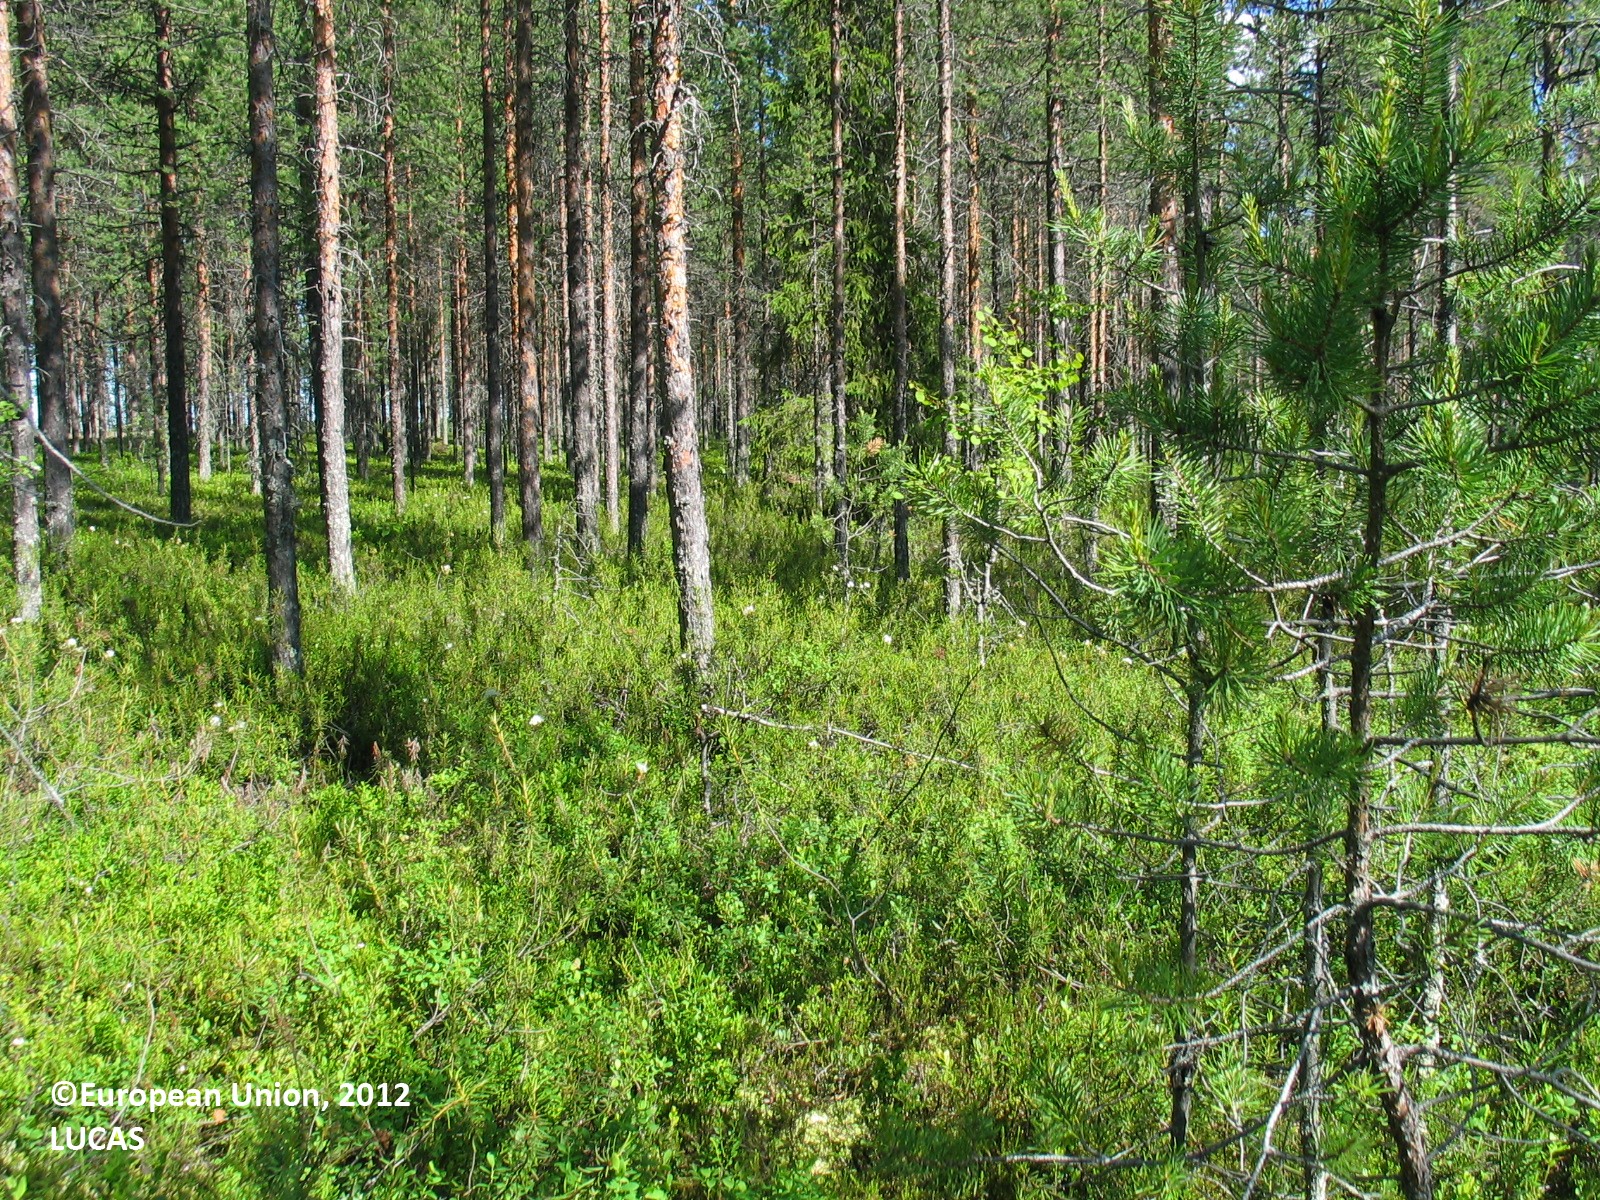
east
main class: Woodland
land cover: Pine dominated coniferous woodland
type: mire and swamp forests
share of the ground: 25 - 50 %
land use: Forestry
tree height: > 5 m
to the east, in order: Pine dominated coniferous woodland; Ditches and canals; Paved roads, cycling and walking lanes; Ditches and canals; Pine dominated coniferous woodland; Peatbogs
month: July
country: FI
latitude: 64.6997
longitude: 26.6199
